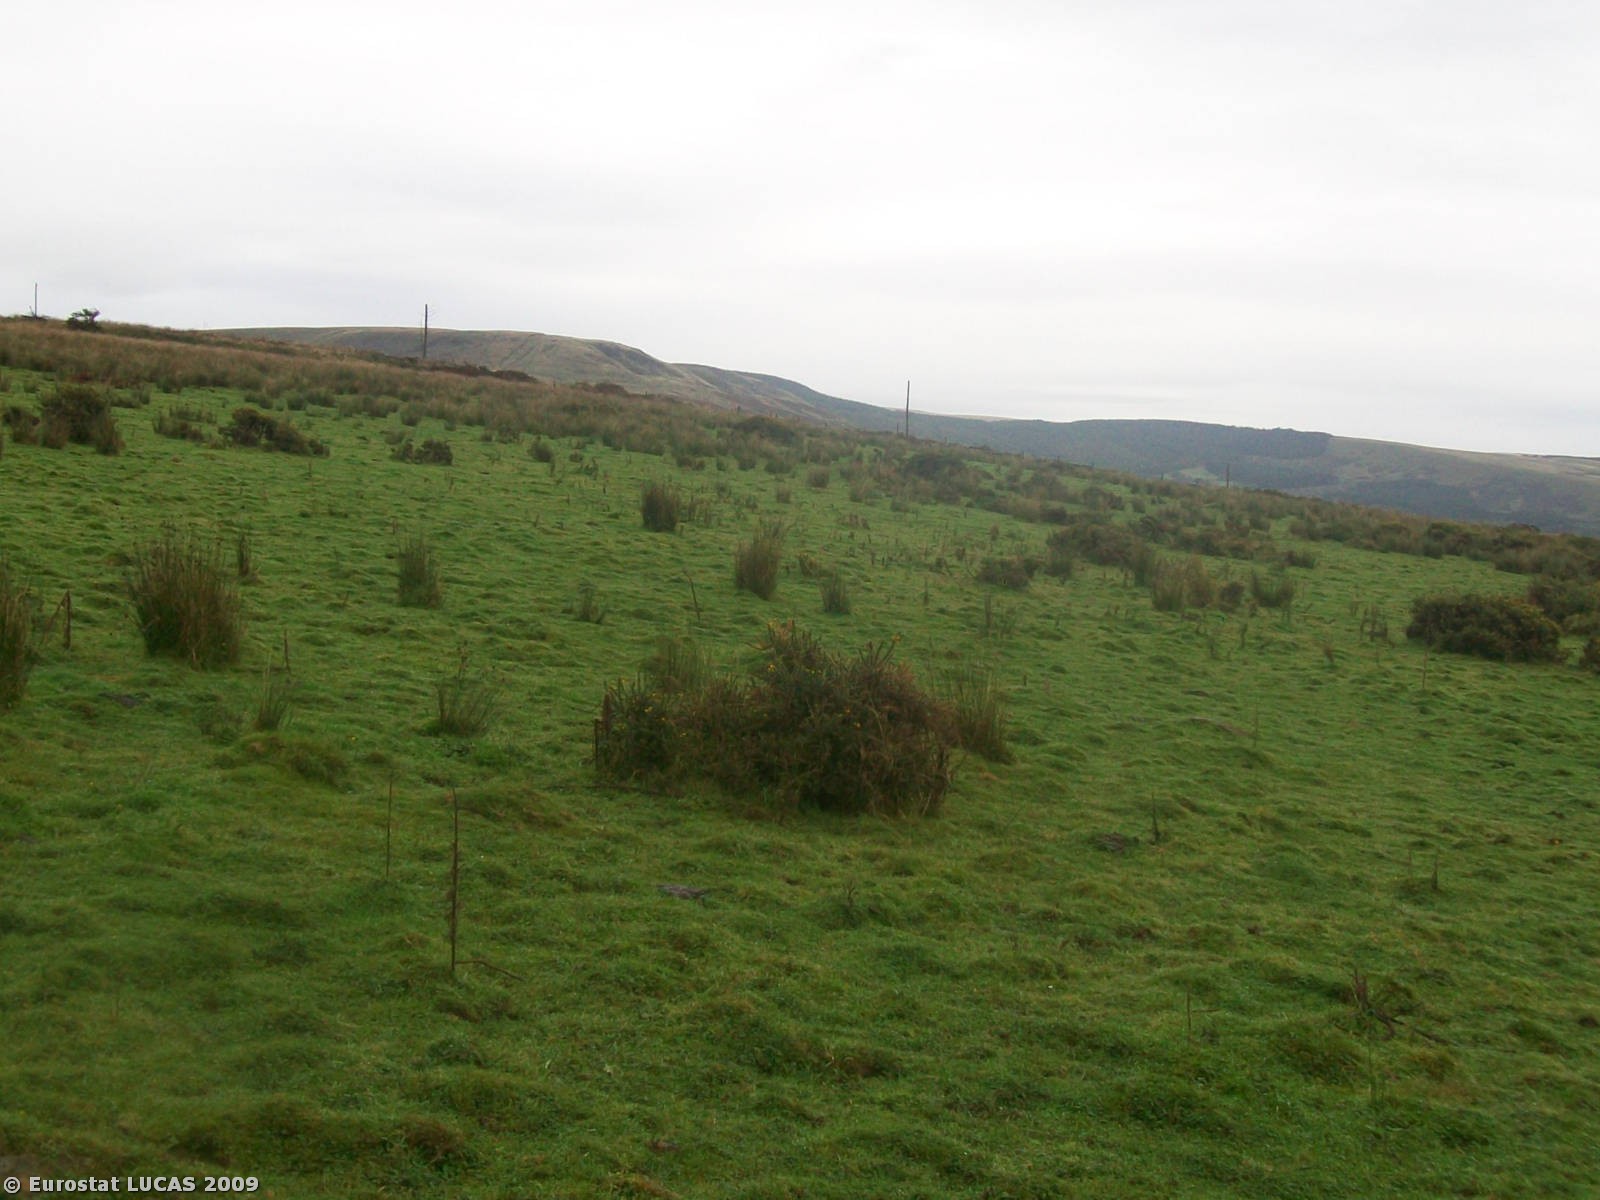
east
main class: Grassland
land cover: Grassland without tree/shrub cover
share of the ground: > 75 %
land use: Agriculture (excluding fallow land and kitchen gardens)
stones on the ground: > 50 %
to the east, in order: Grassland without tree/shrub cover; Dry stone walls; Grass margins; Fences; Grassland without tree/shrub cover
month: September
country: GB
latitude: 51.6172
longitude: -3.6785
